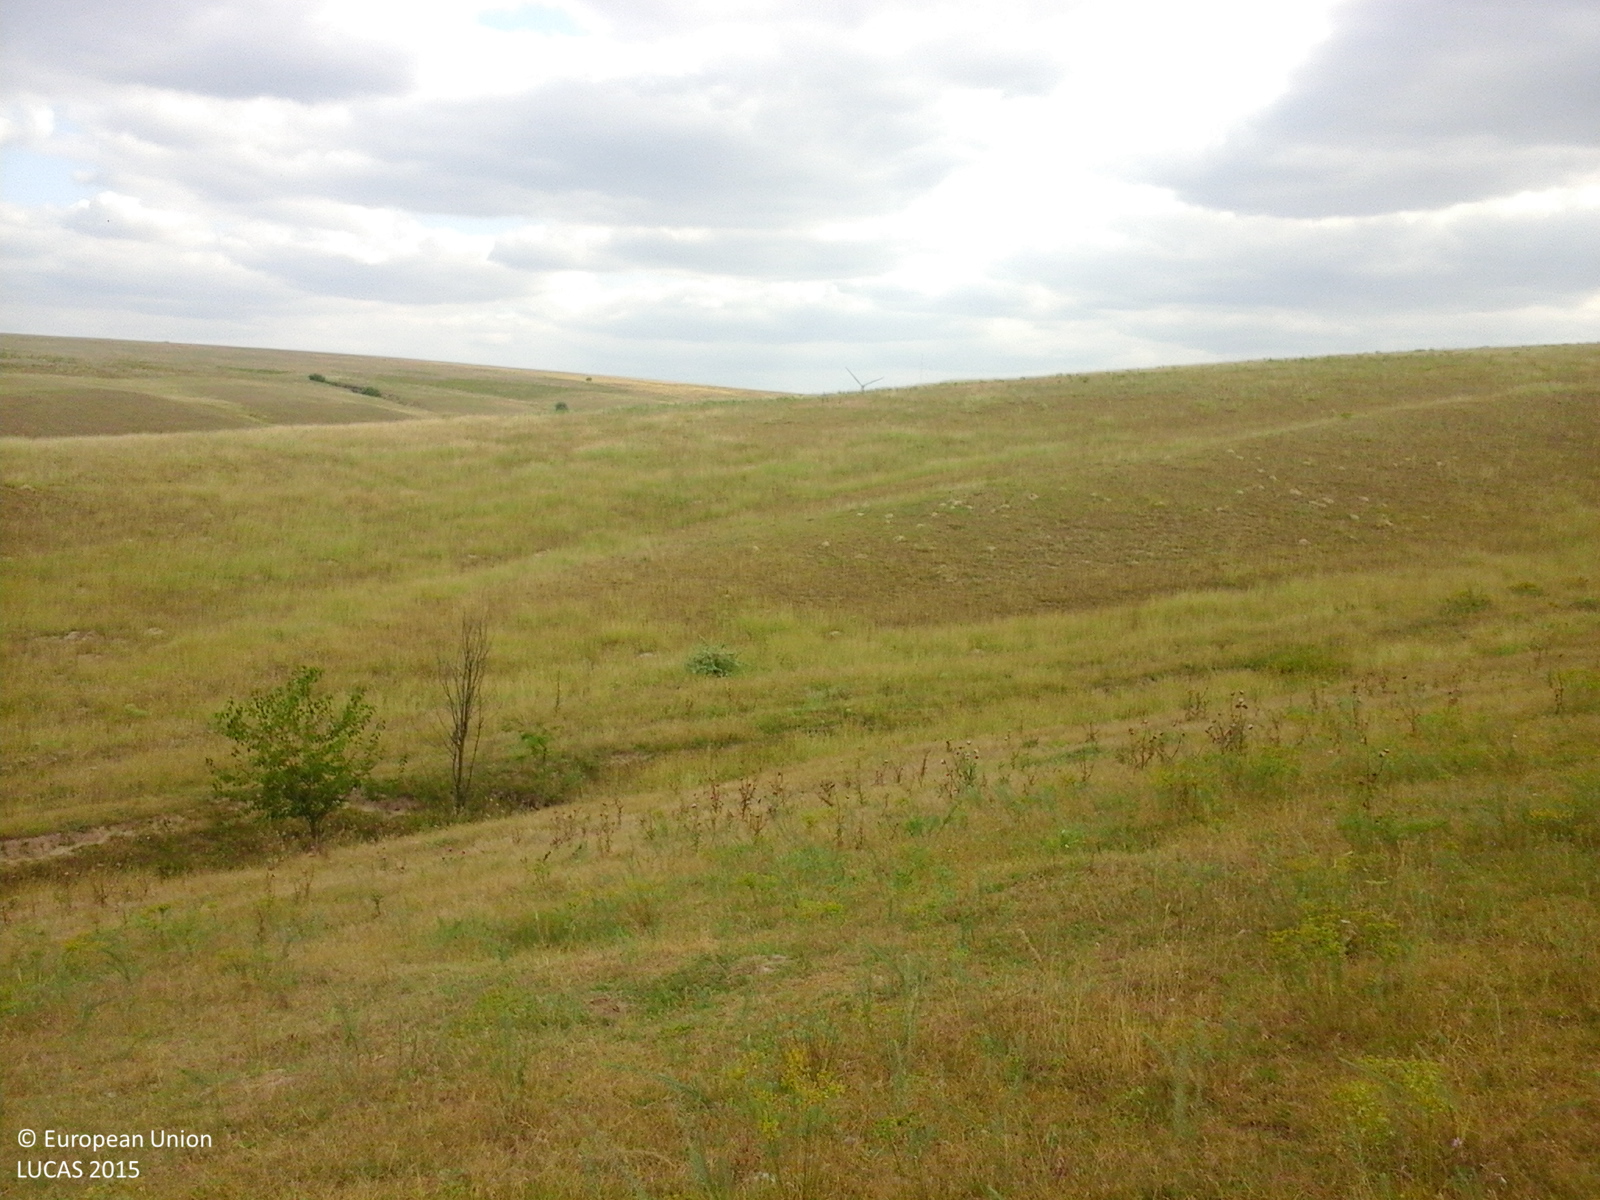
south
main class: Grassland
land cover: Grassland without tree/shrub cover
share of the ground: > 75 %
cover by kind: herbaceous plants 100 %
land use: Agriculture (excluding fallow land and kitchen gardens)
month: August
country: RO
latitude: 44.7118
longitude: 28.1264
